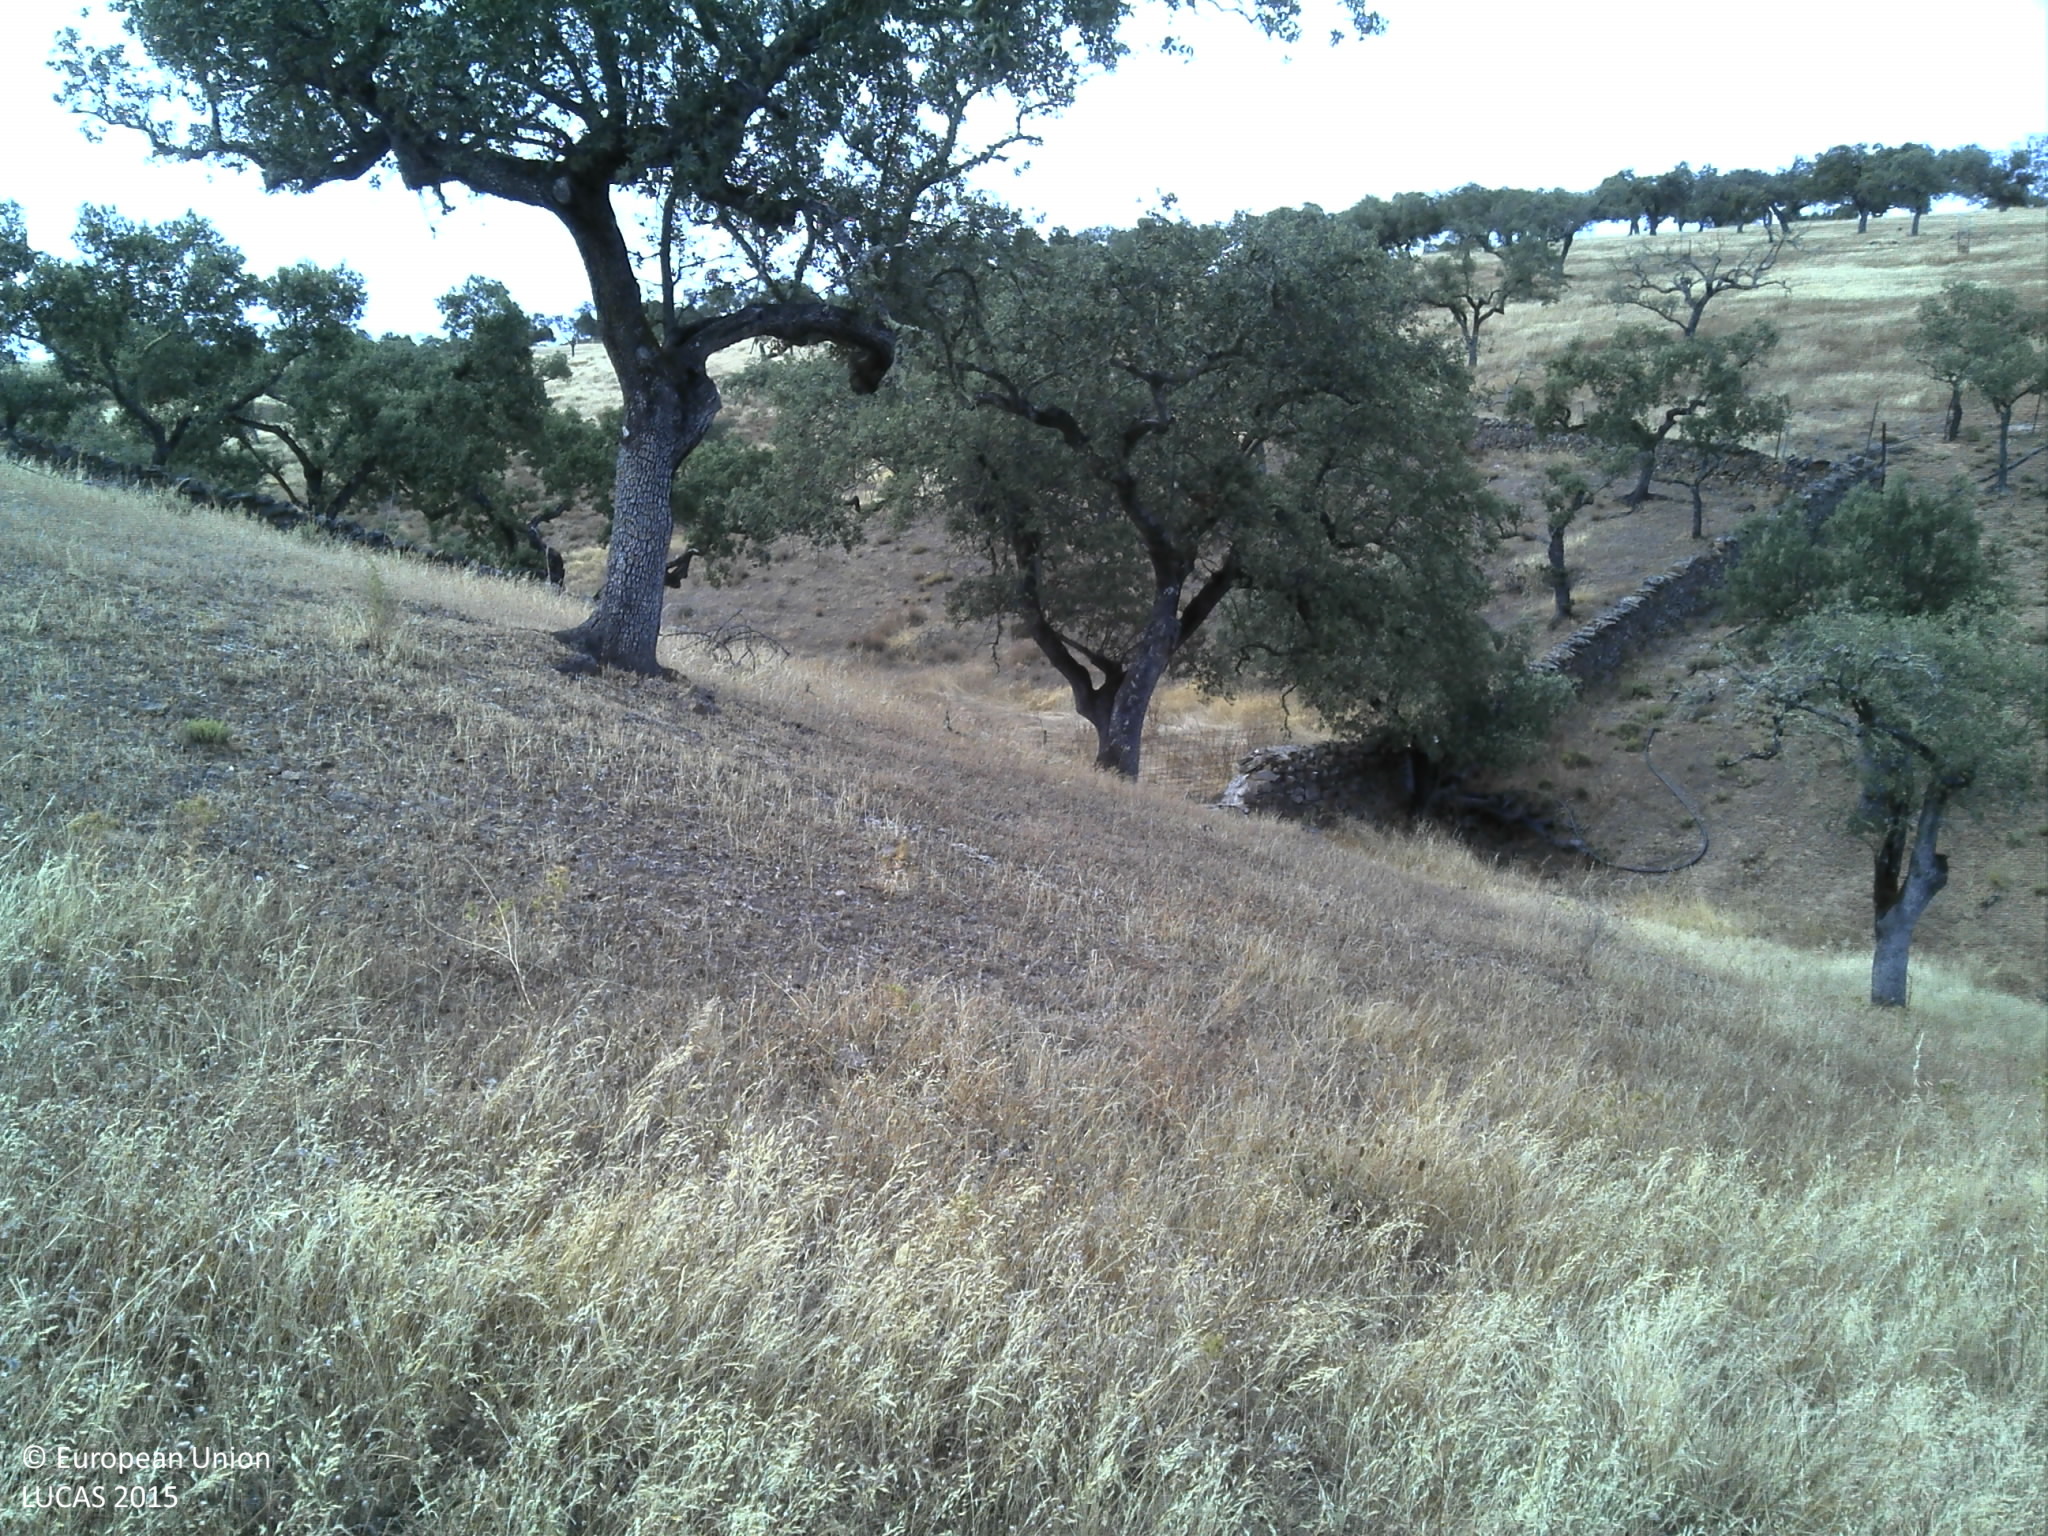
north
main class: Woodland
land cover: Broadleaved woodland
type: broadleaved evergreen forest
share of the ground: 10 - 25 %
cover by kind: unconsolidated bare surface 45 %, broadleaved forest trees 25 %, herbaceous plants 25 %
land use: Forestry
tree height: > 5 m
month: July
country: PT
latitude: 38.1277
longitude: -7.0902
